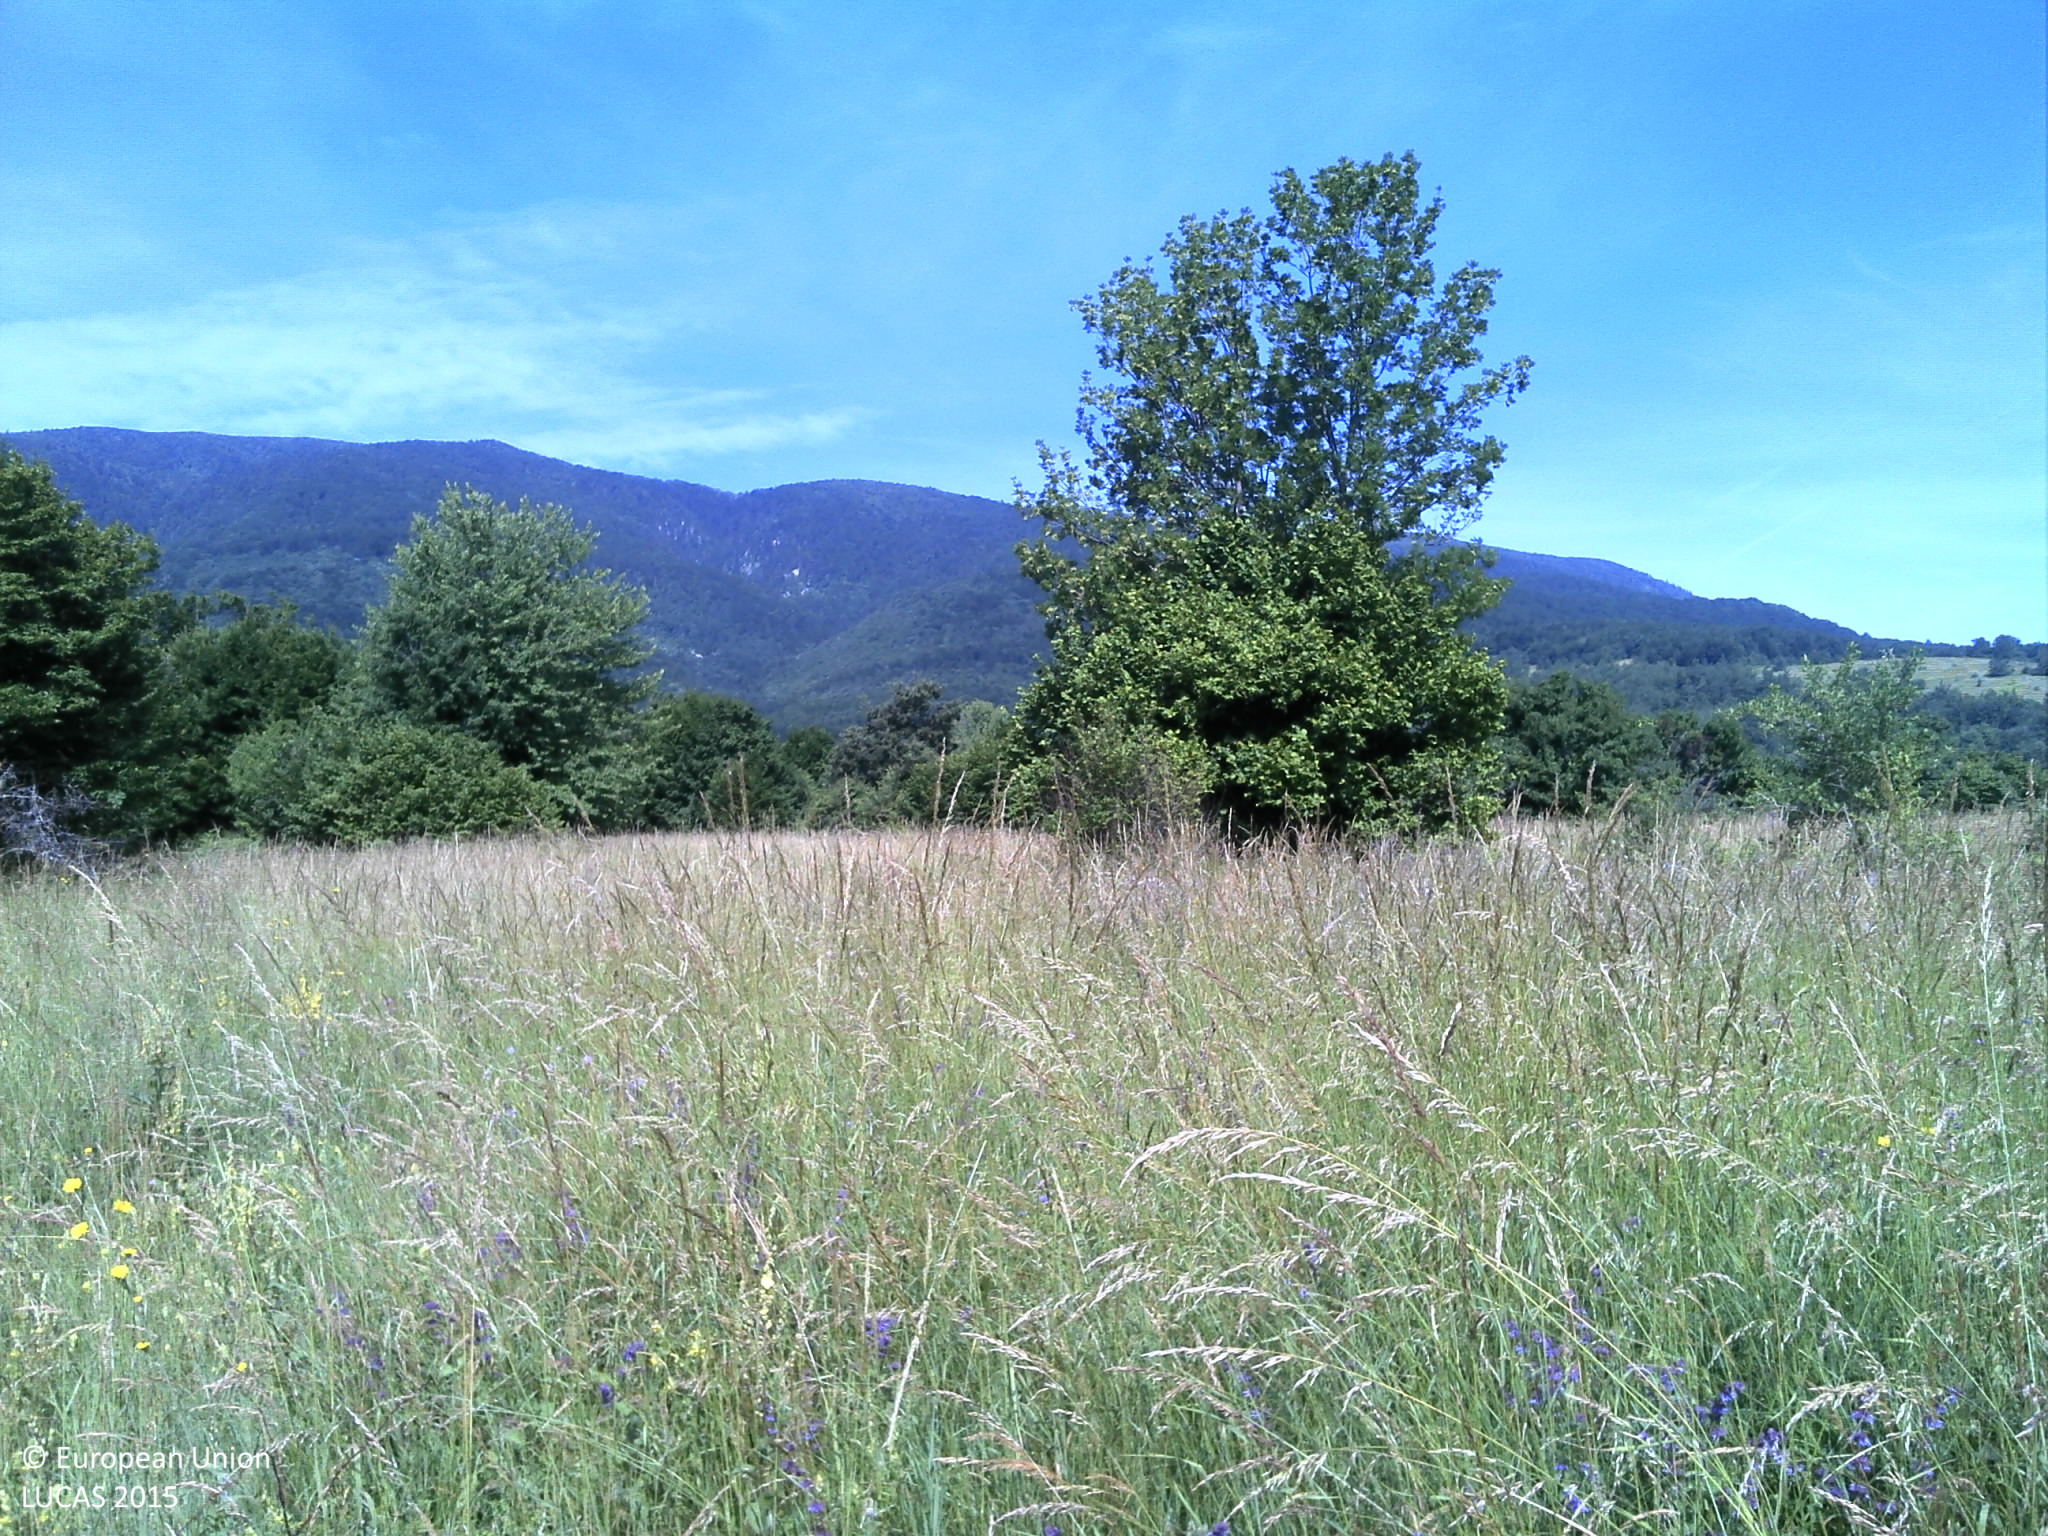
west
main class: Grassland
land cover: Grassland without tree/shrub cover
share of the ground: > 75 %
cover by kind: herbaceous plants 100 %
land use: Semi-natural and natural areas not in use
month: June
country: HR
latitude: 44.5789
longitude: 15.9258
